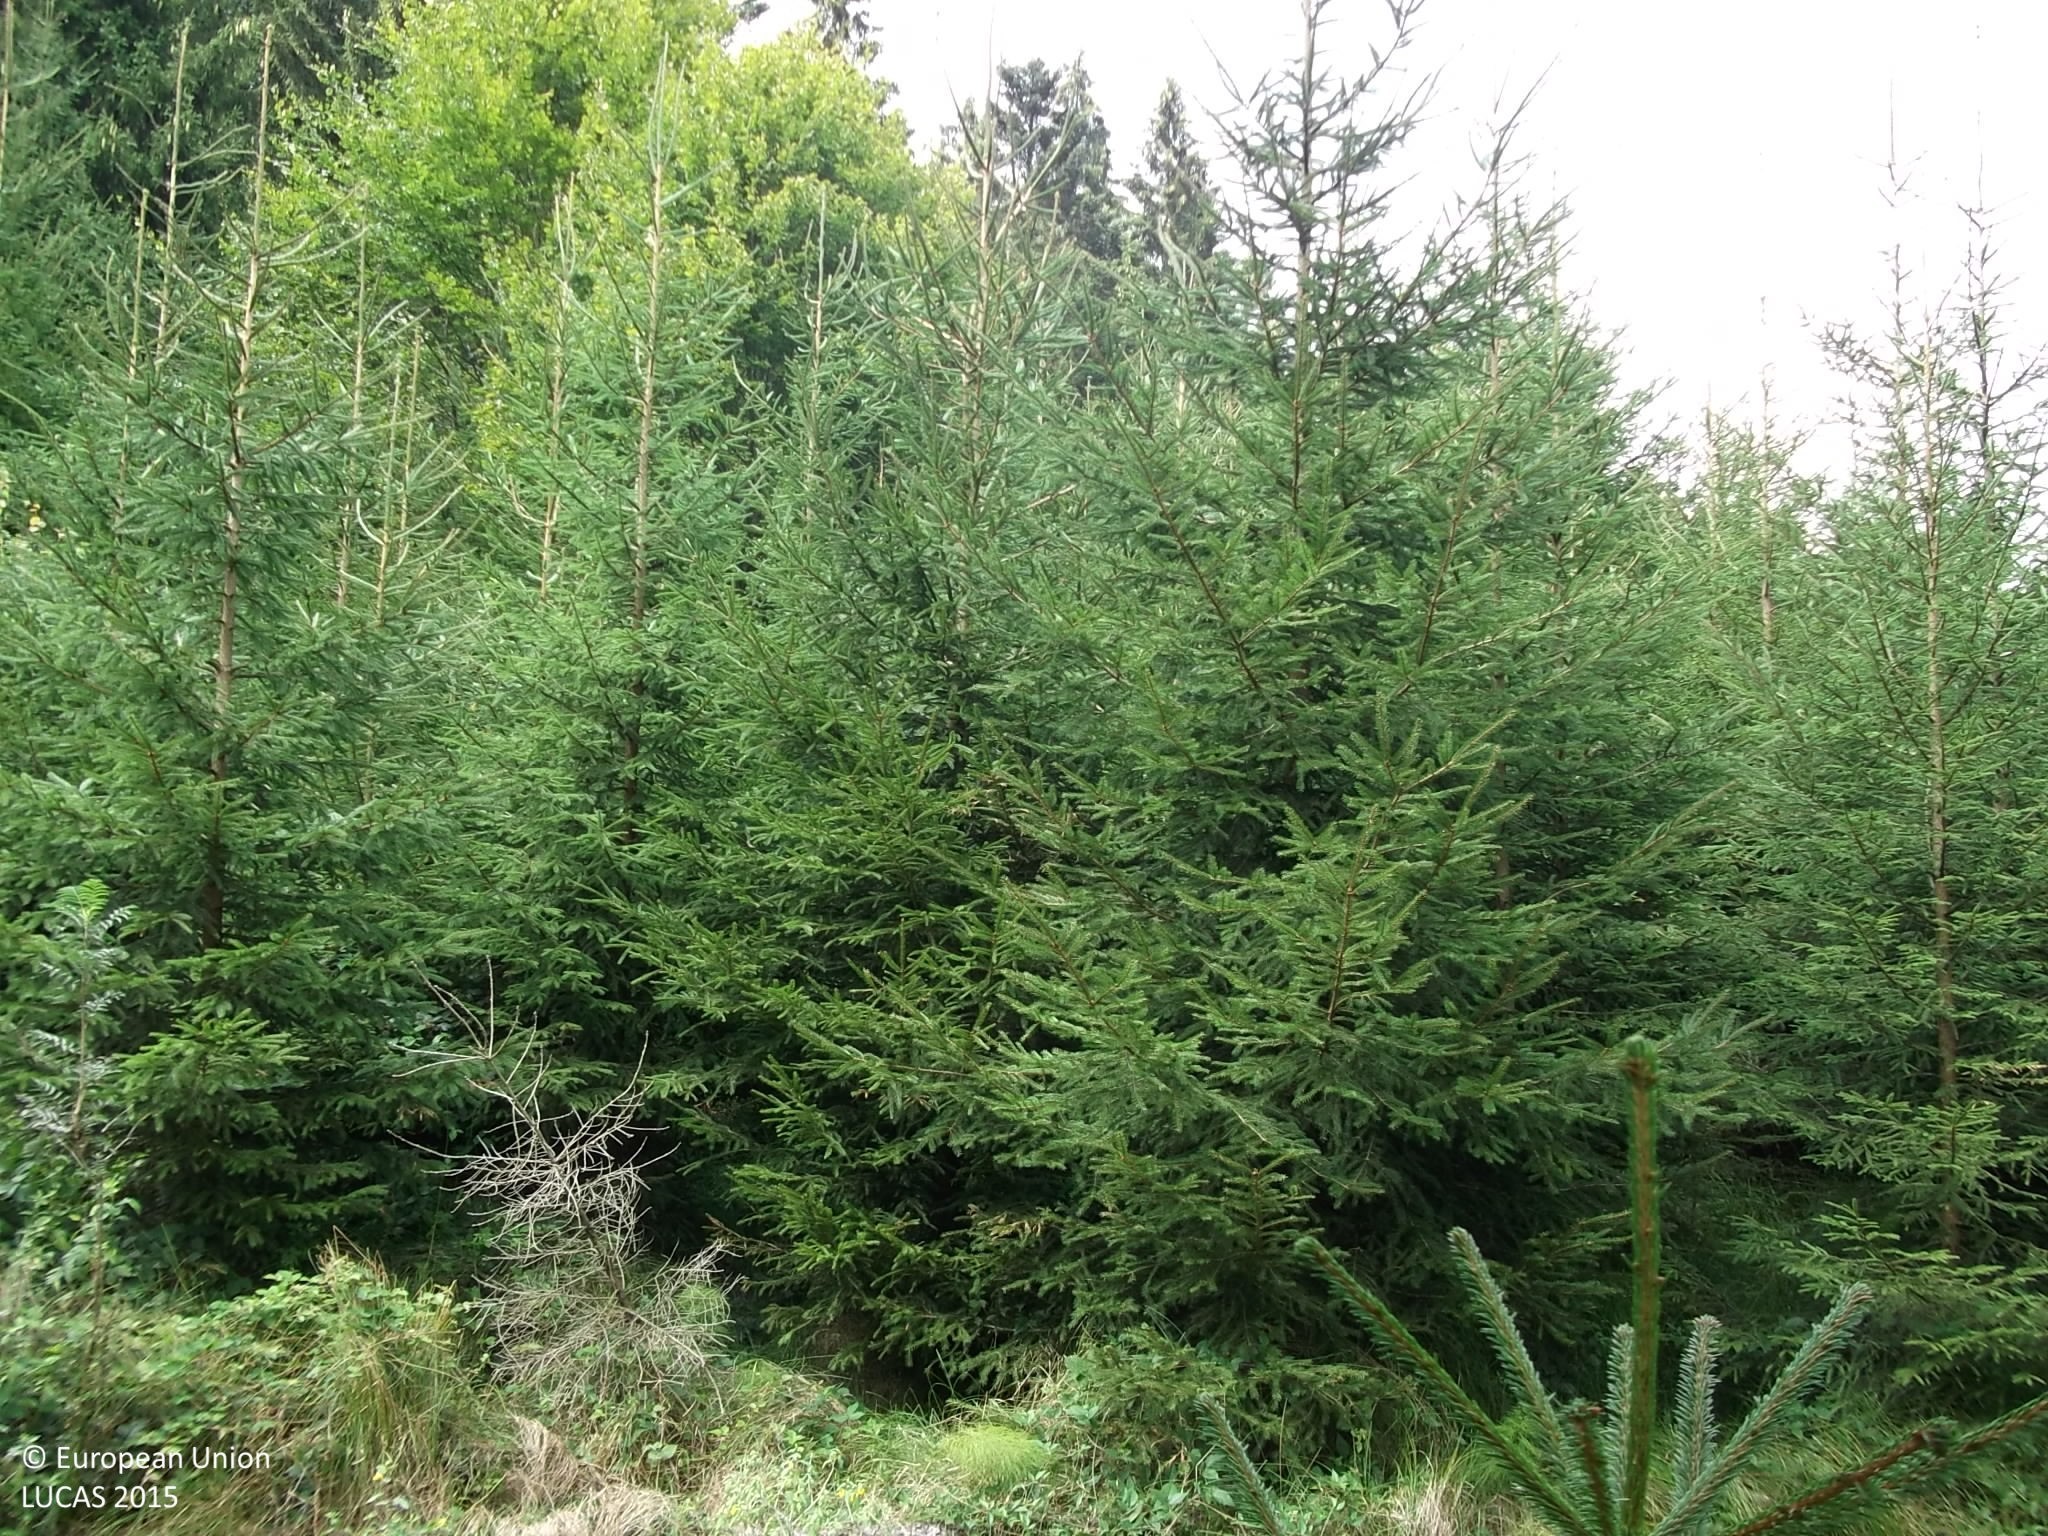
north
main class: Grassland
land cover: Grassland with sparse tree/shrub cover
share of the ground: > 75 %
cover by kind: herbaceous plants 90 %, coniferous forest trees 5 %, shrubs 5 %
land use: Forestry
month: August
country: AT
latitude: 47.9742
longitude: 13.3613
